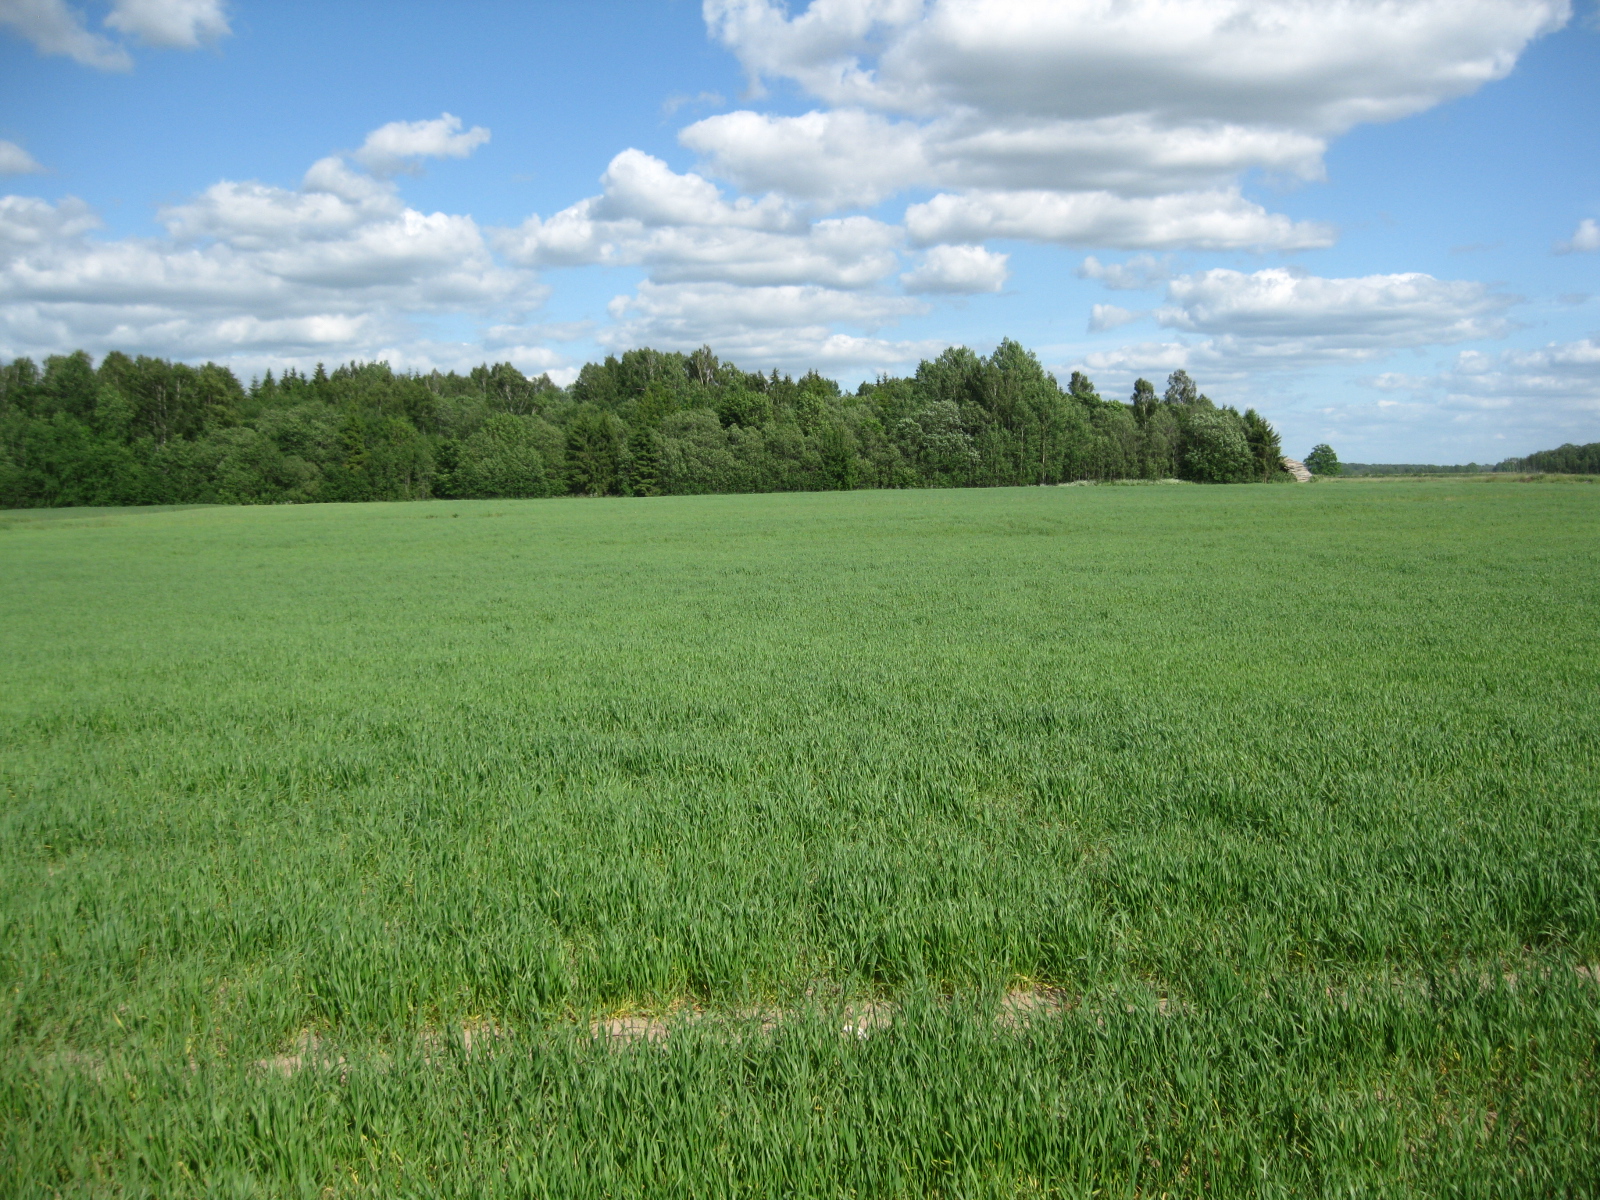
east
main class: Cropland
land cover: Triticale
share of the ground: > 75 %
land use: Agriculture (excluding fallow land and kitchen gardens)
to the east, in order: Triticale; Grass margins; Tracks; Grass margins; Triticale; Broadleaved woodland
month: June
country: LT
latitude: 55.6274
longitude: 23.5637
